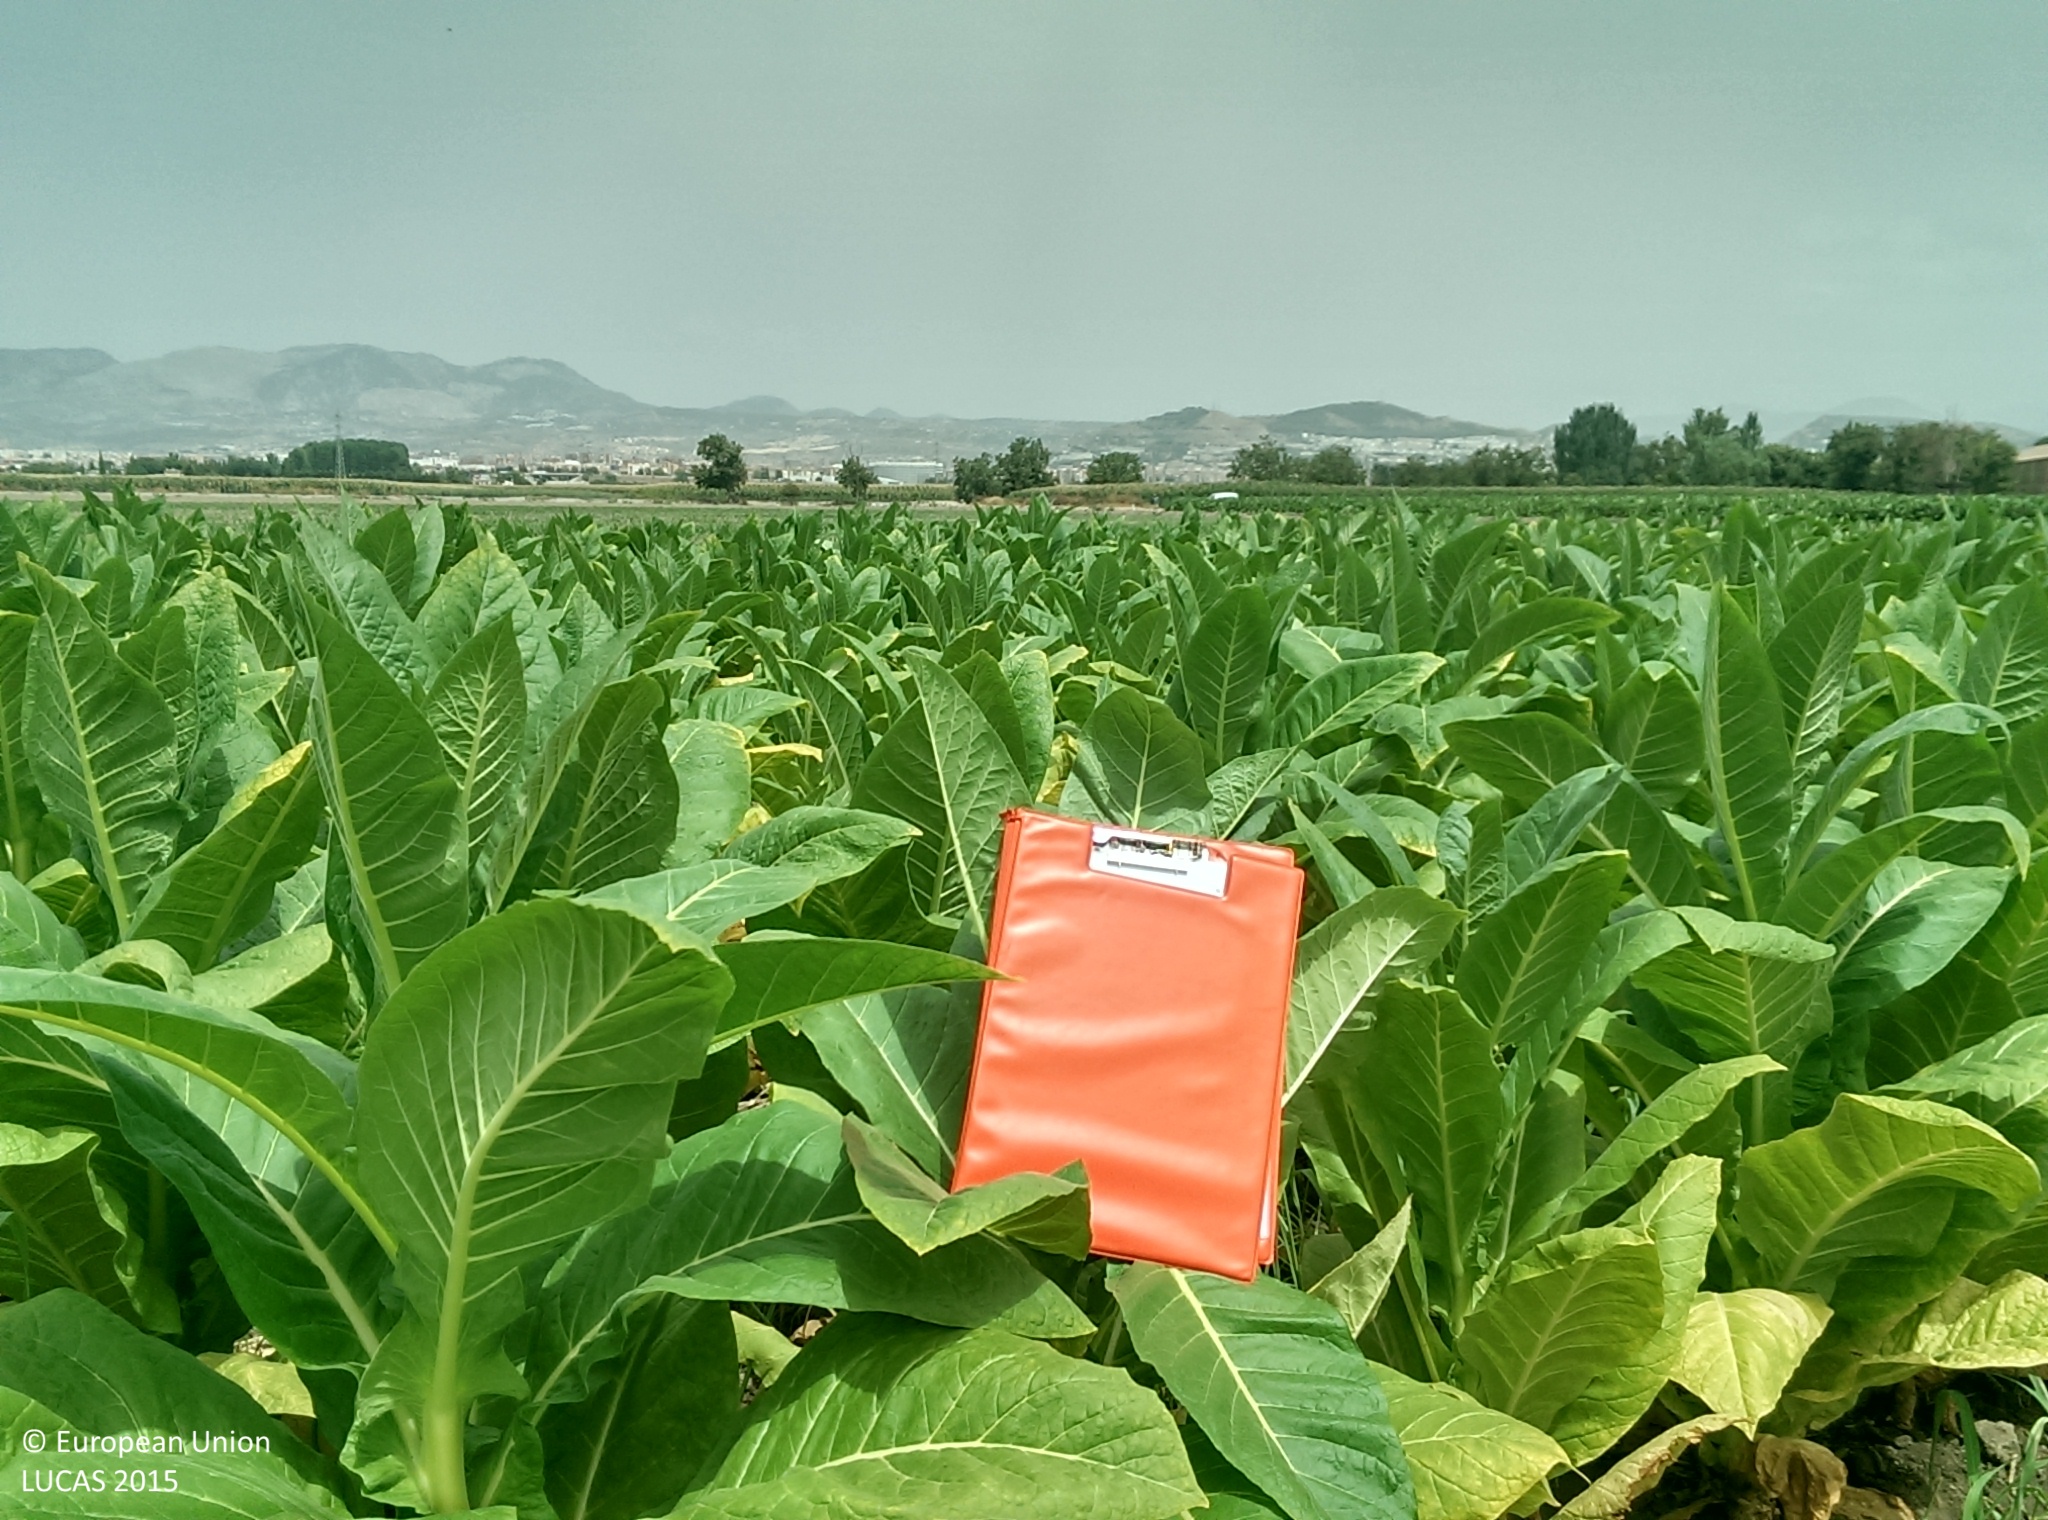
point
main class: Cropland
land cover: Tobacco
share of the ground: > 75 %
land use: Agriculture (excluding fallow land and kitchen gardens)
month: August
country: ES
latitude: 37.1803
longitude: -3.6526
